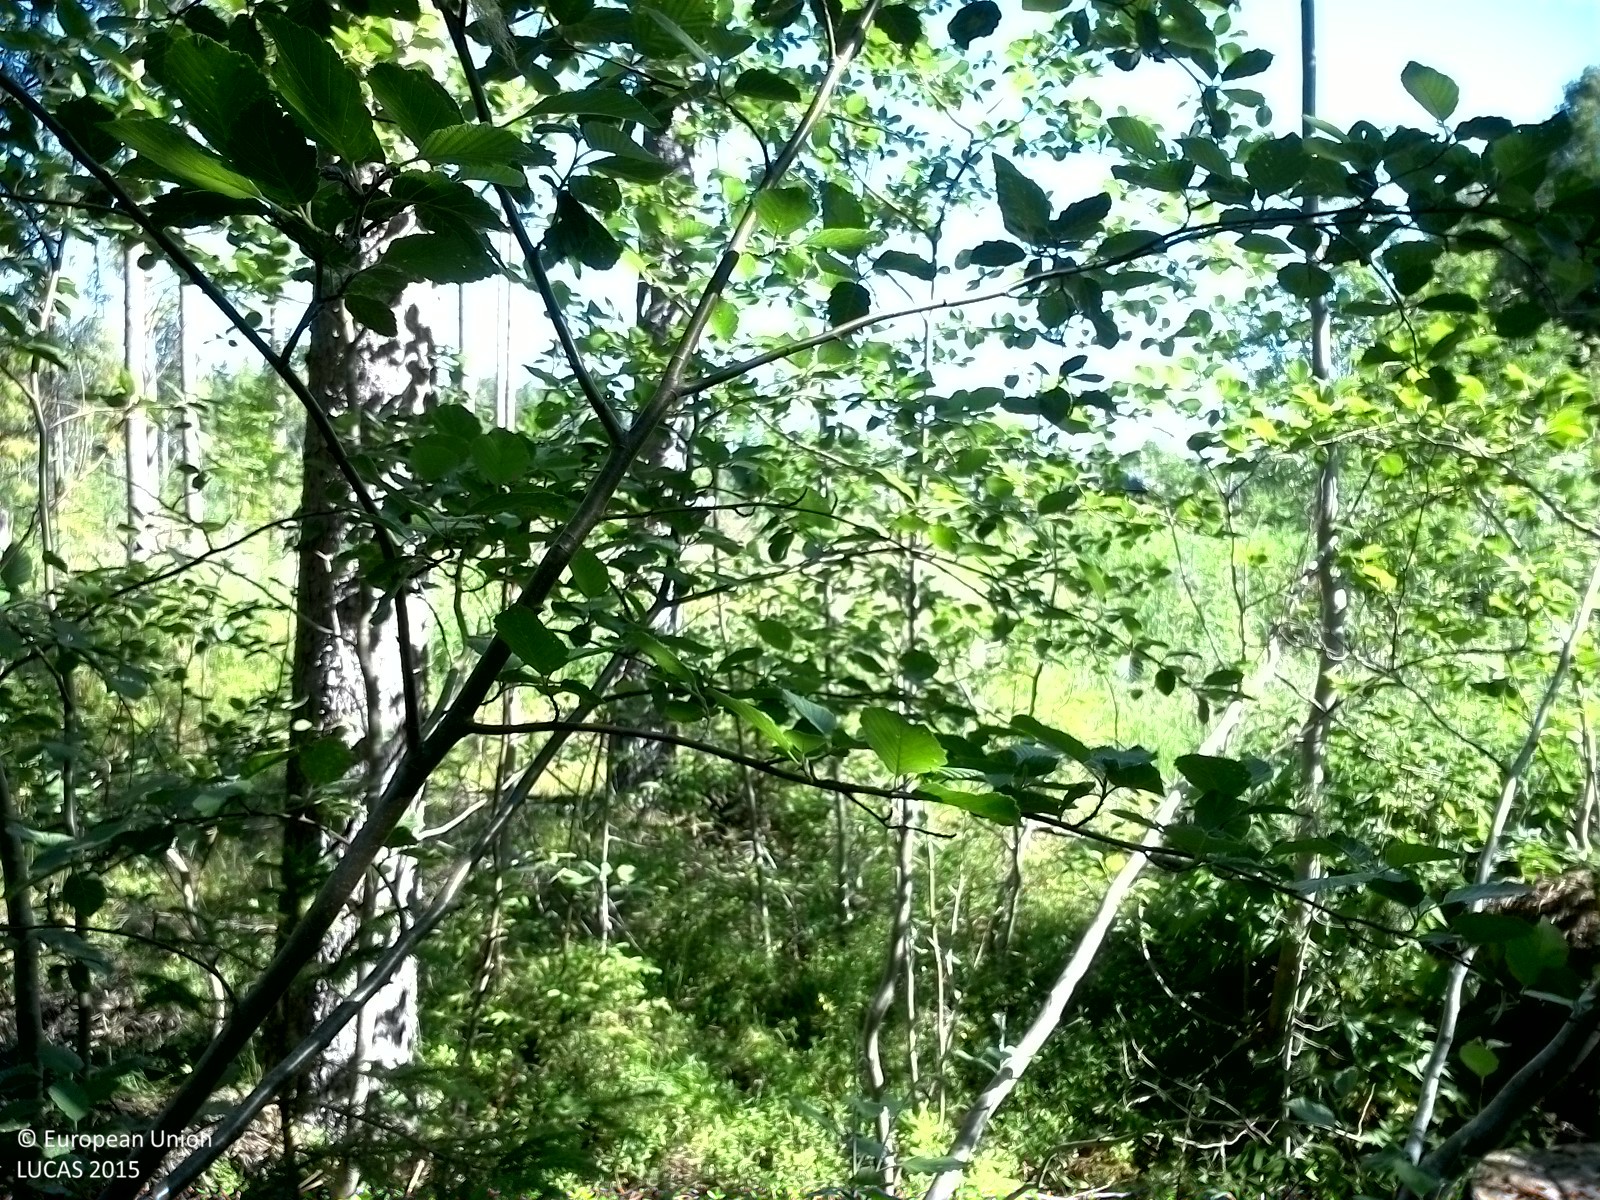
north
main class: Woodland
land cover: Spruce dominated mixed woodland
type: boreal forest
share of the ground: > 75 %
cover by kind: broadleaved forest trees 50 %, coniferous forest trees 35 %, herbaceous plants 15 %
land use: Forestry
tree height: > 5 m
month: July
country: SE
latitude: 62.2697
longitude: 16.9736
